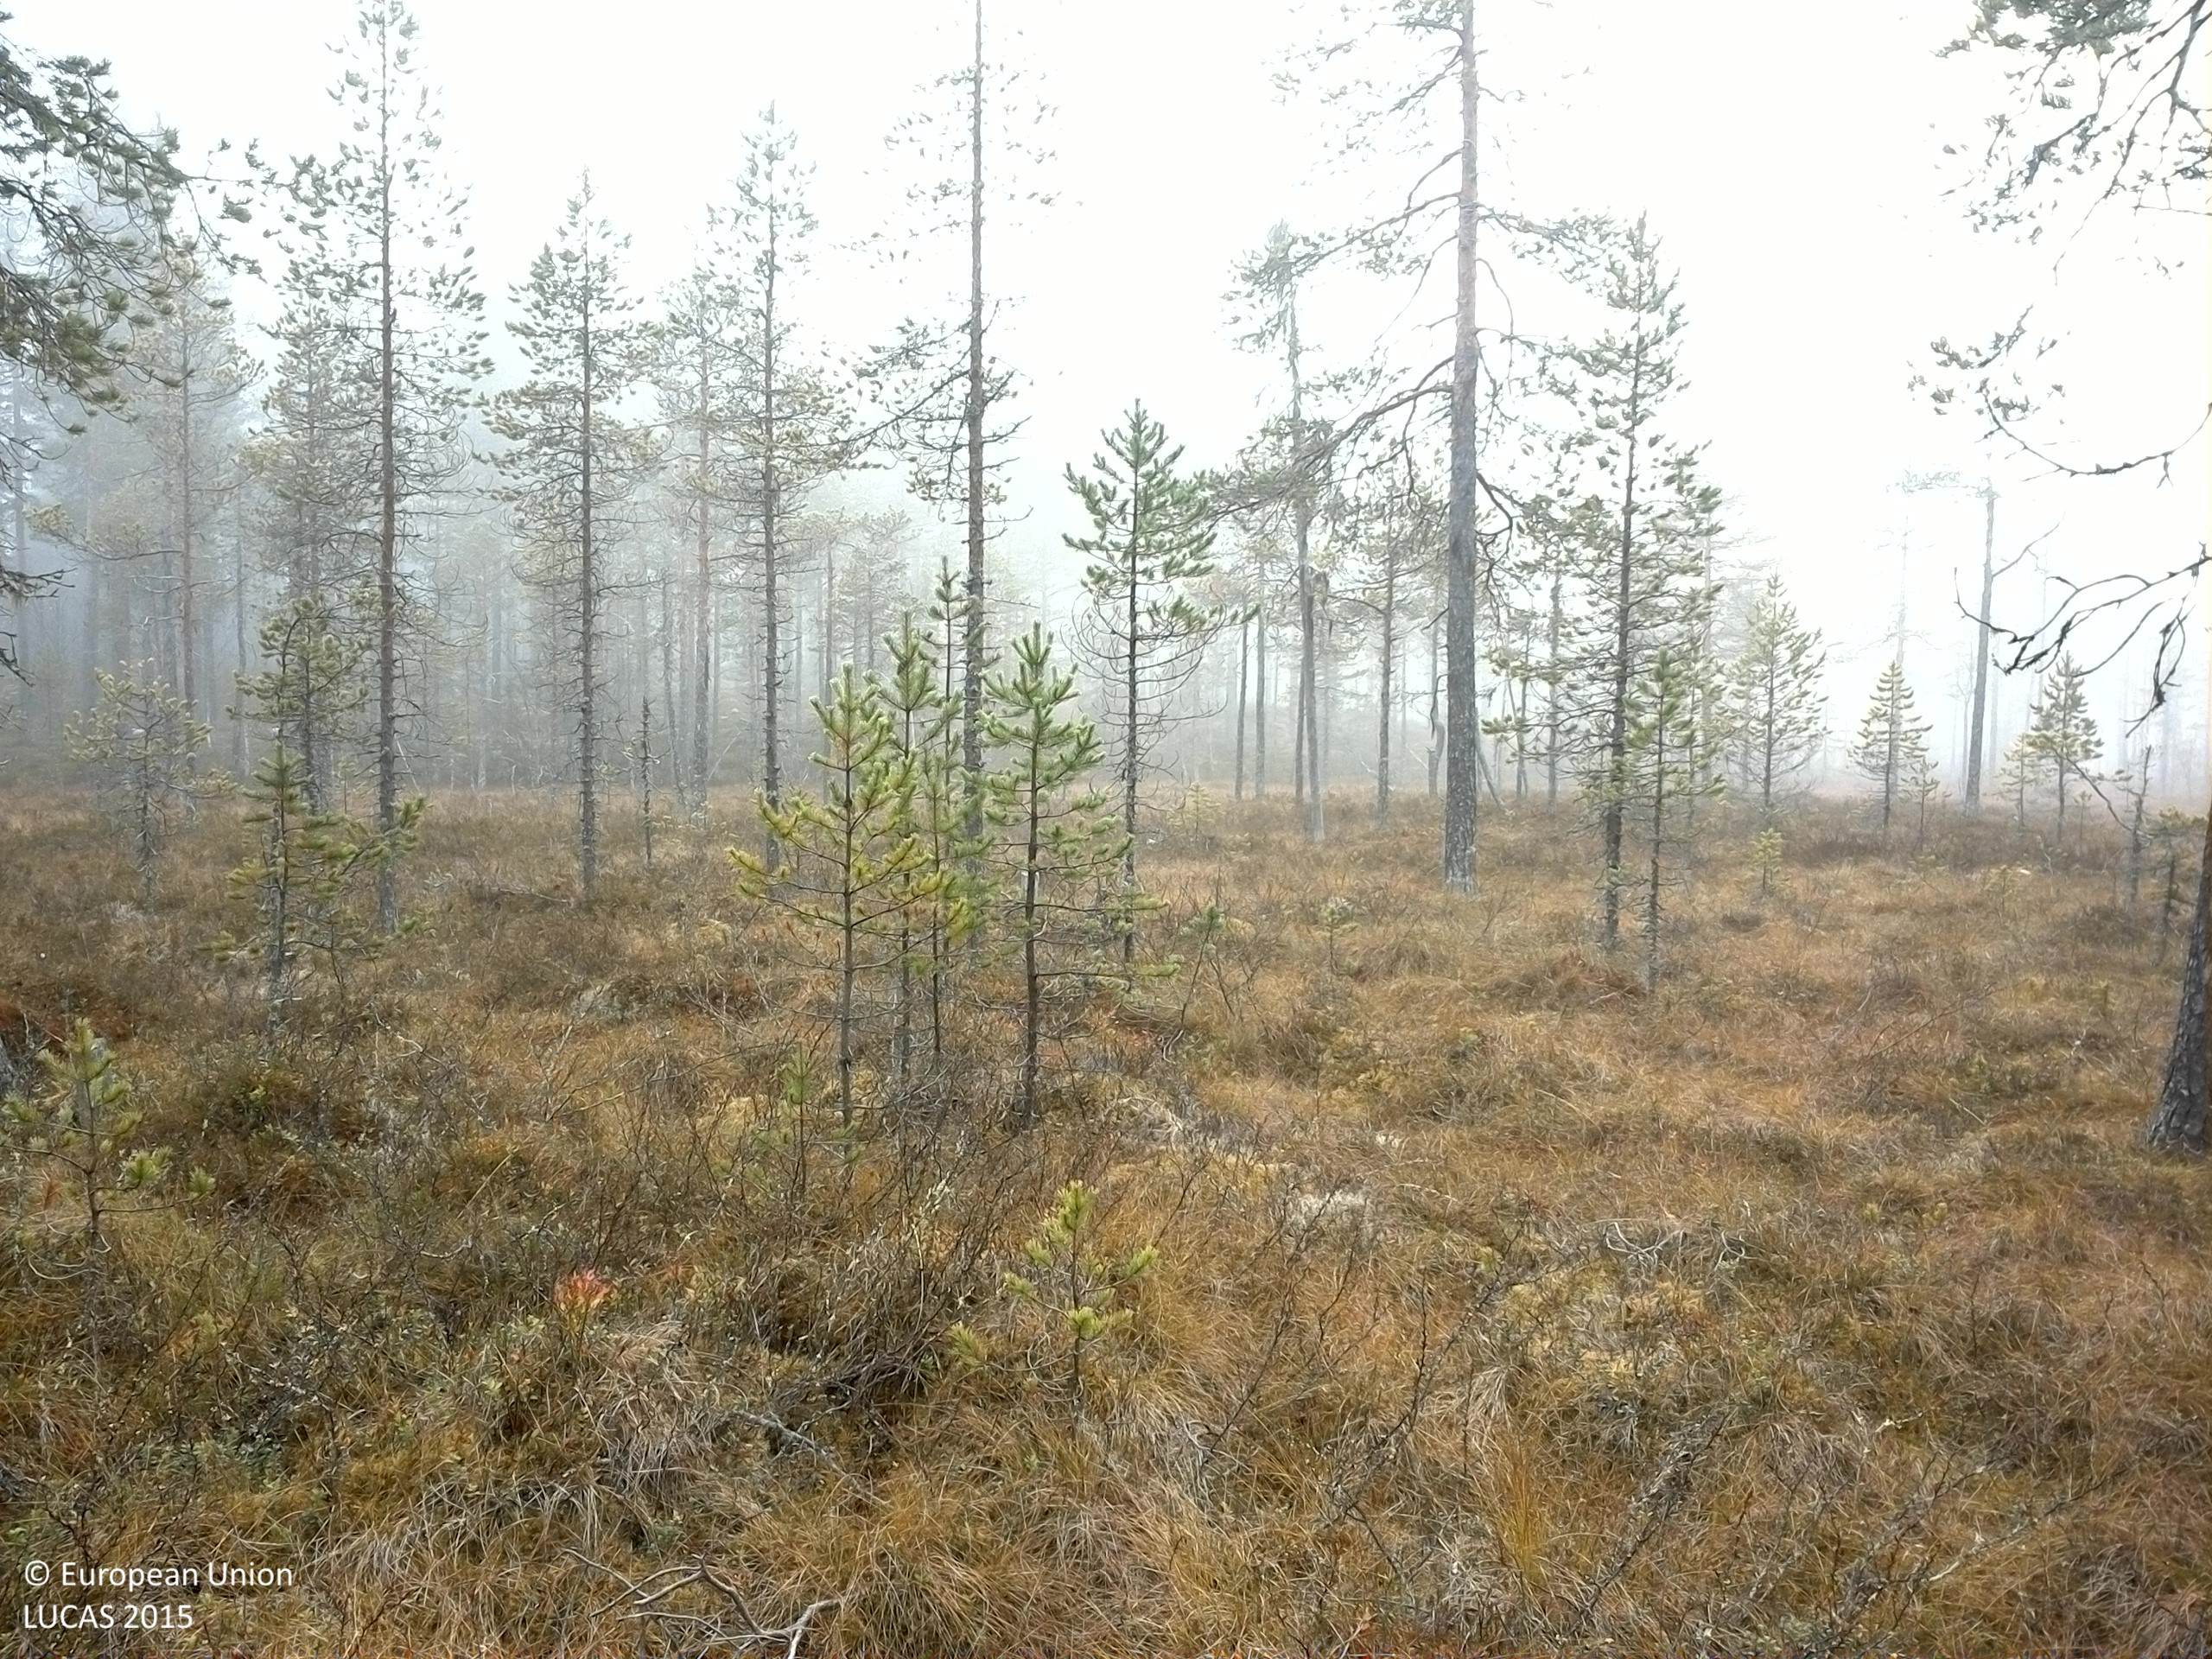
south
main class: Woodland
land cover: Pine dominated coniferous woodland
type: boreal forest
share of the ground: 25 - 50 %
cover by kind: coniferous forest trees 30 %, shrubs 25 %, lichens and mosses 25 %, herbaceous plants 20 %
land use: Forestry
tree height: > 5 m
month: October
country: SE
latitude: 64.0523
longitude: 16.3822
